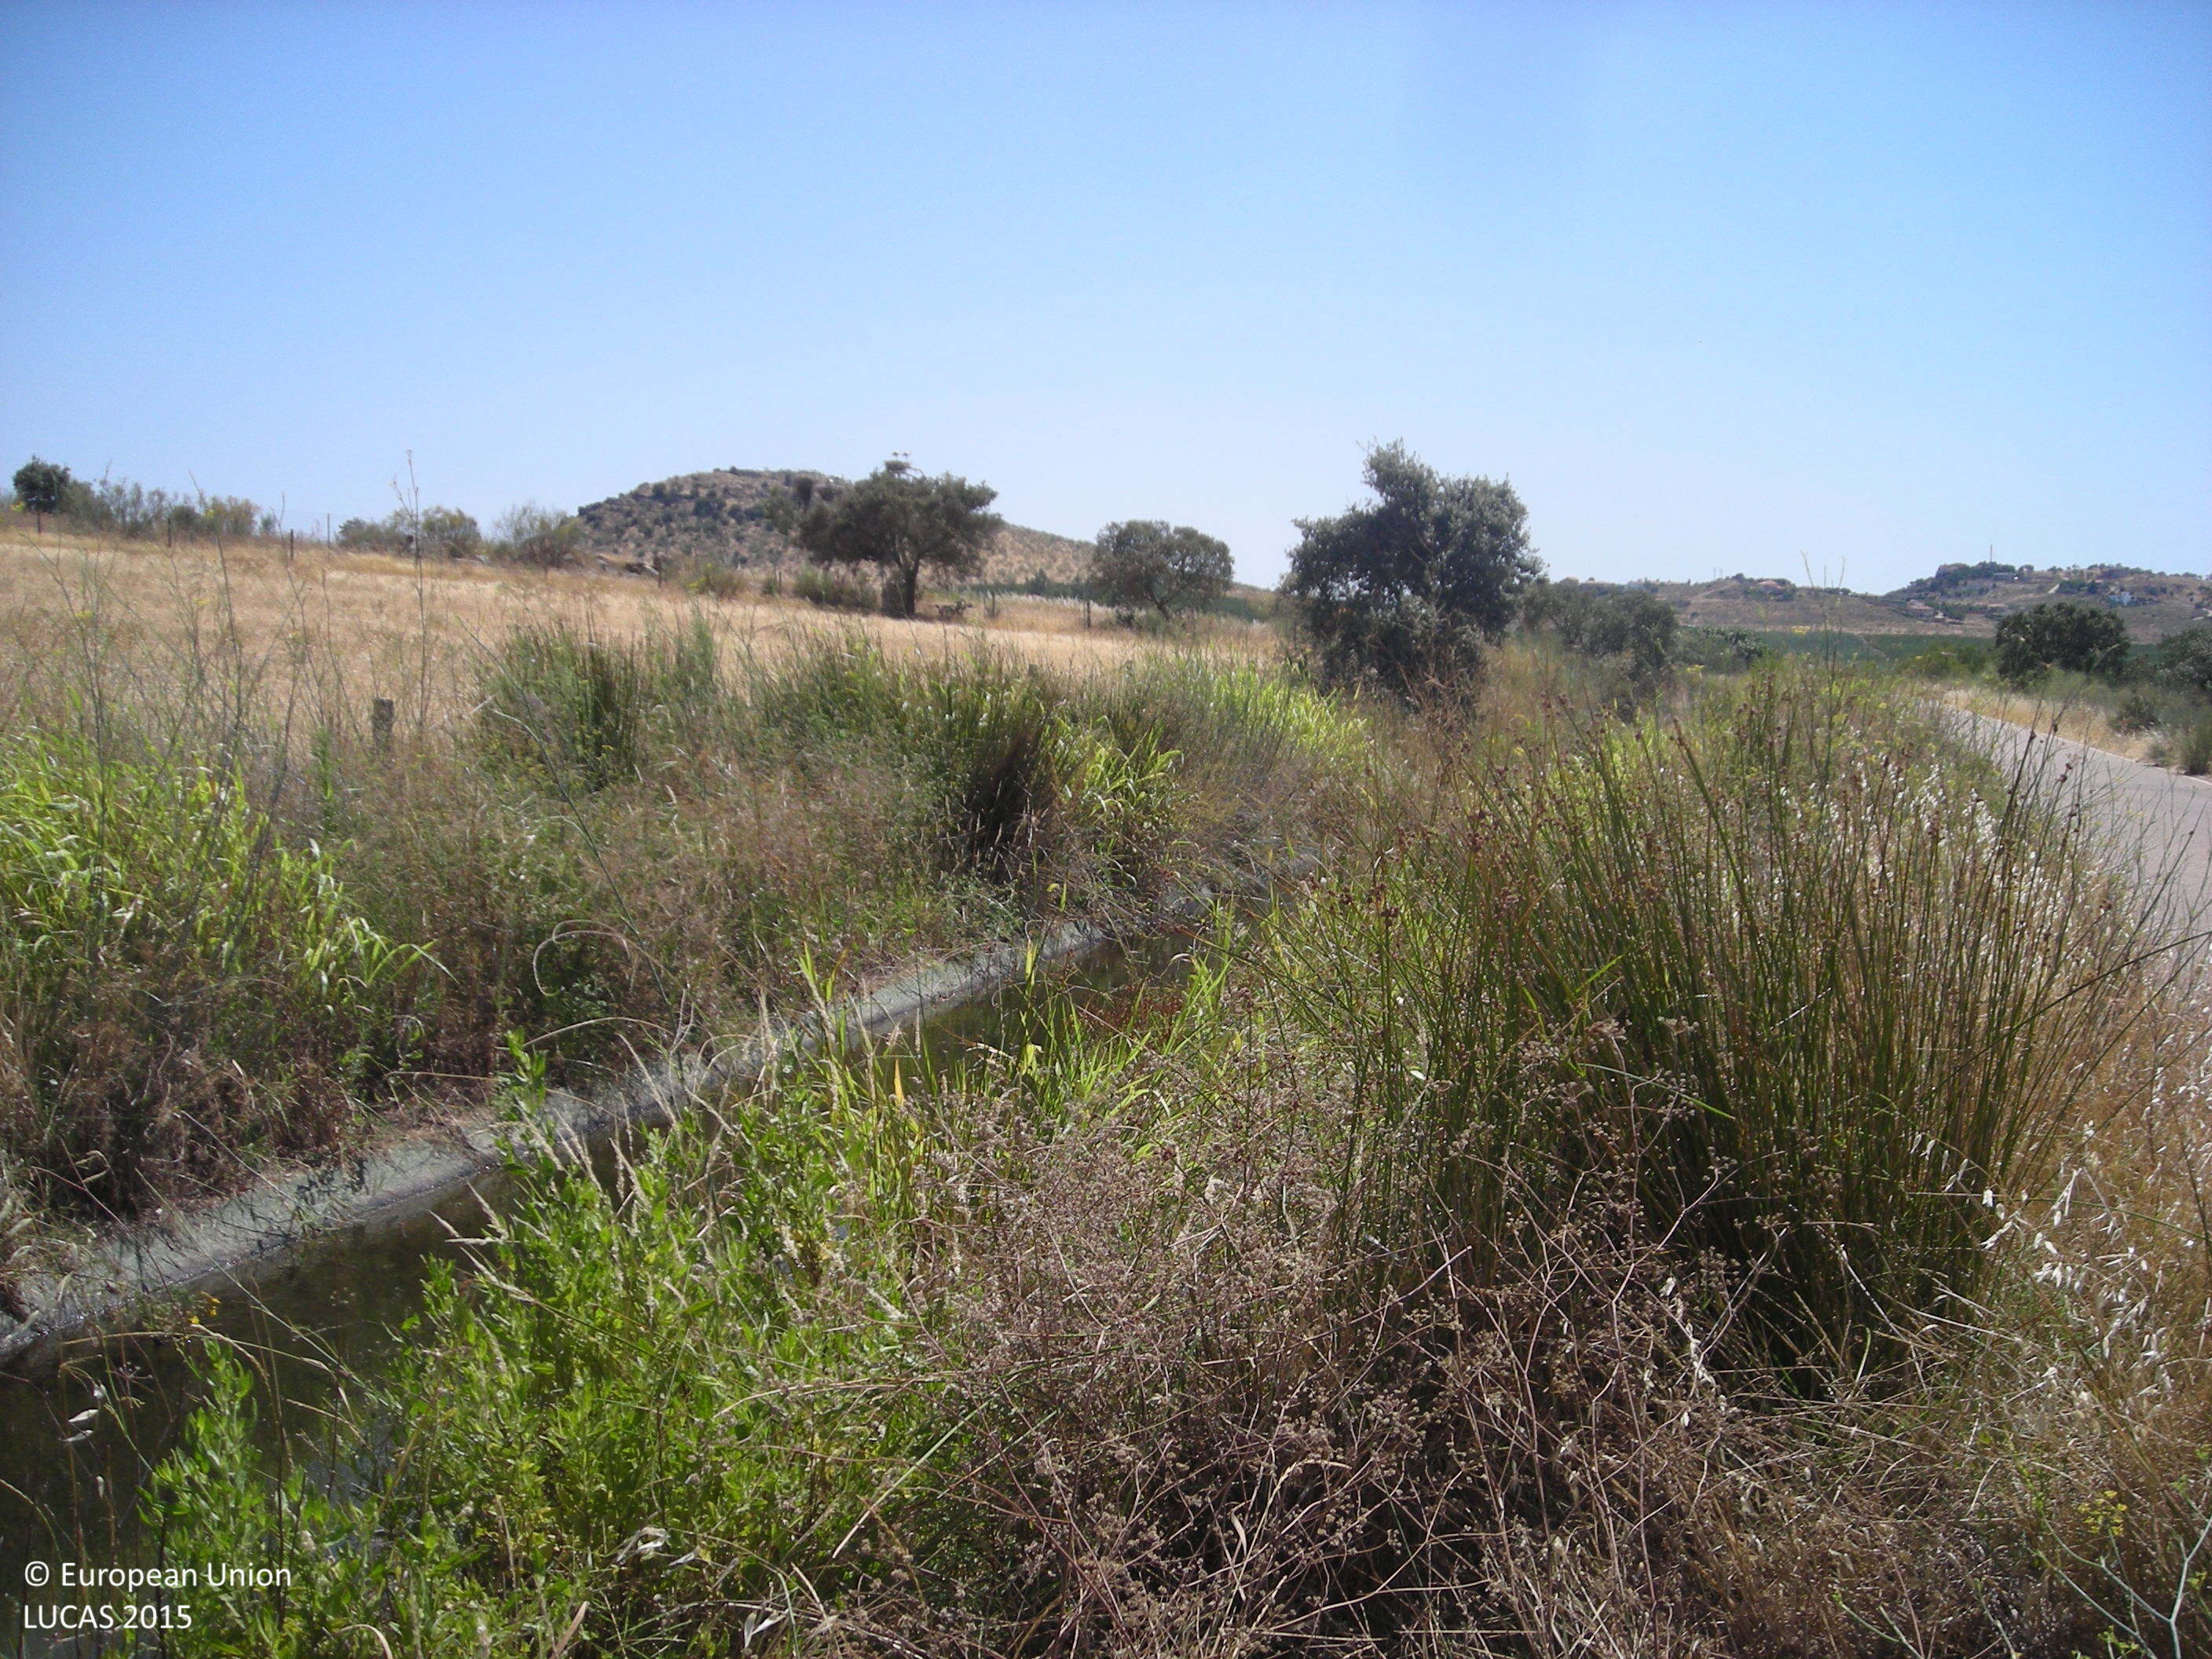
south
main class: Grassland
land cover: Grassland without tree/shrub cover
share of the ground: > 75 %
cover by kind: herbaceous plants 100 %
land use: Agriculture (excluding fallow land and kitchen gardens)
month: July
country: ES
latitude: 38.9900
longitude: -5.9491
